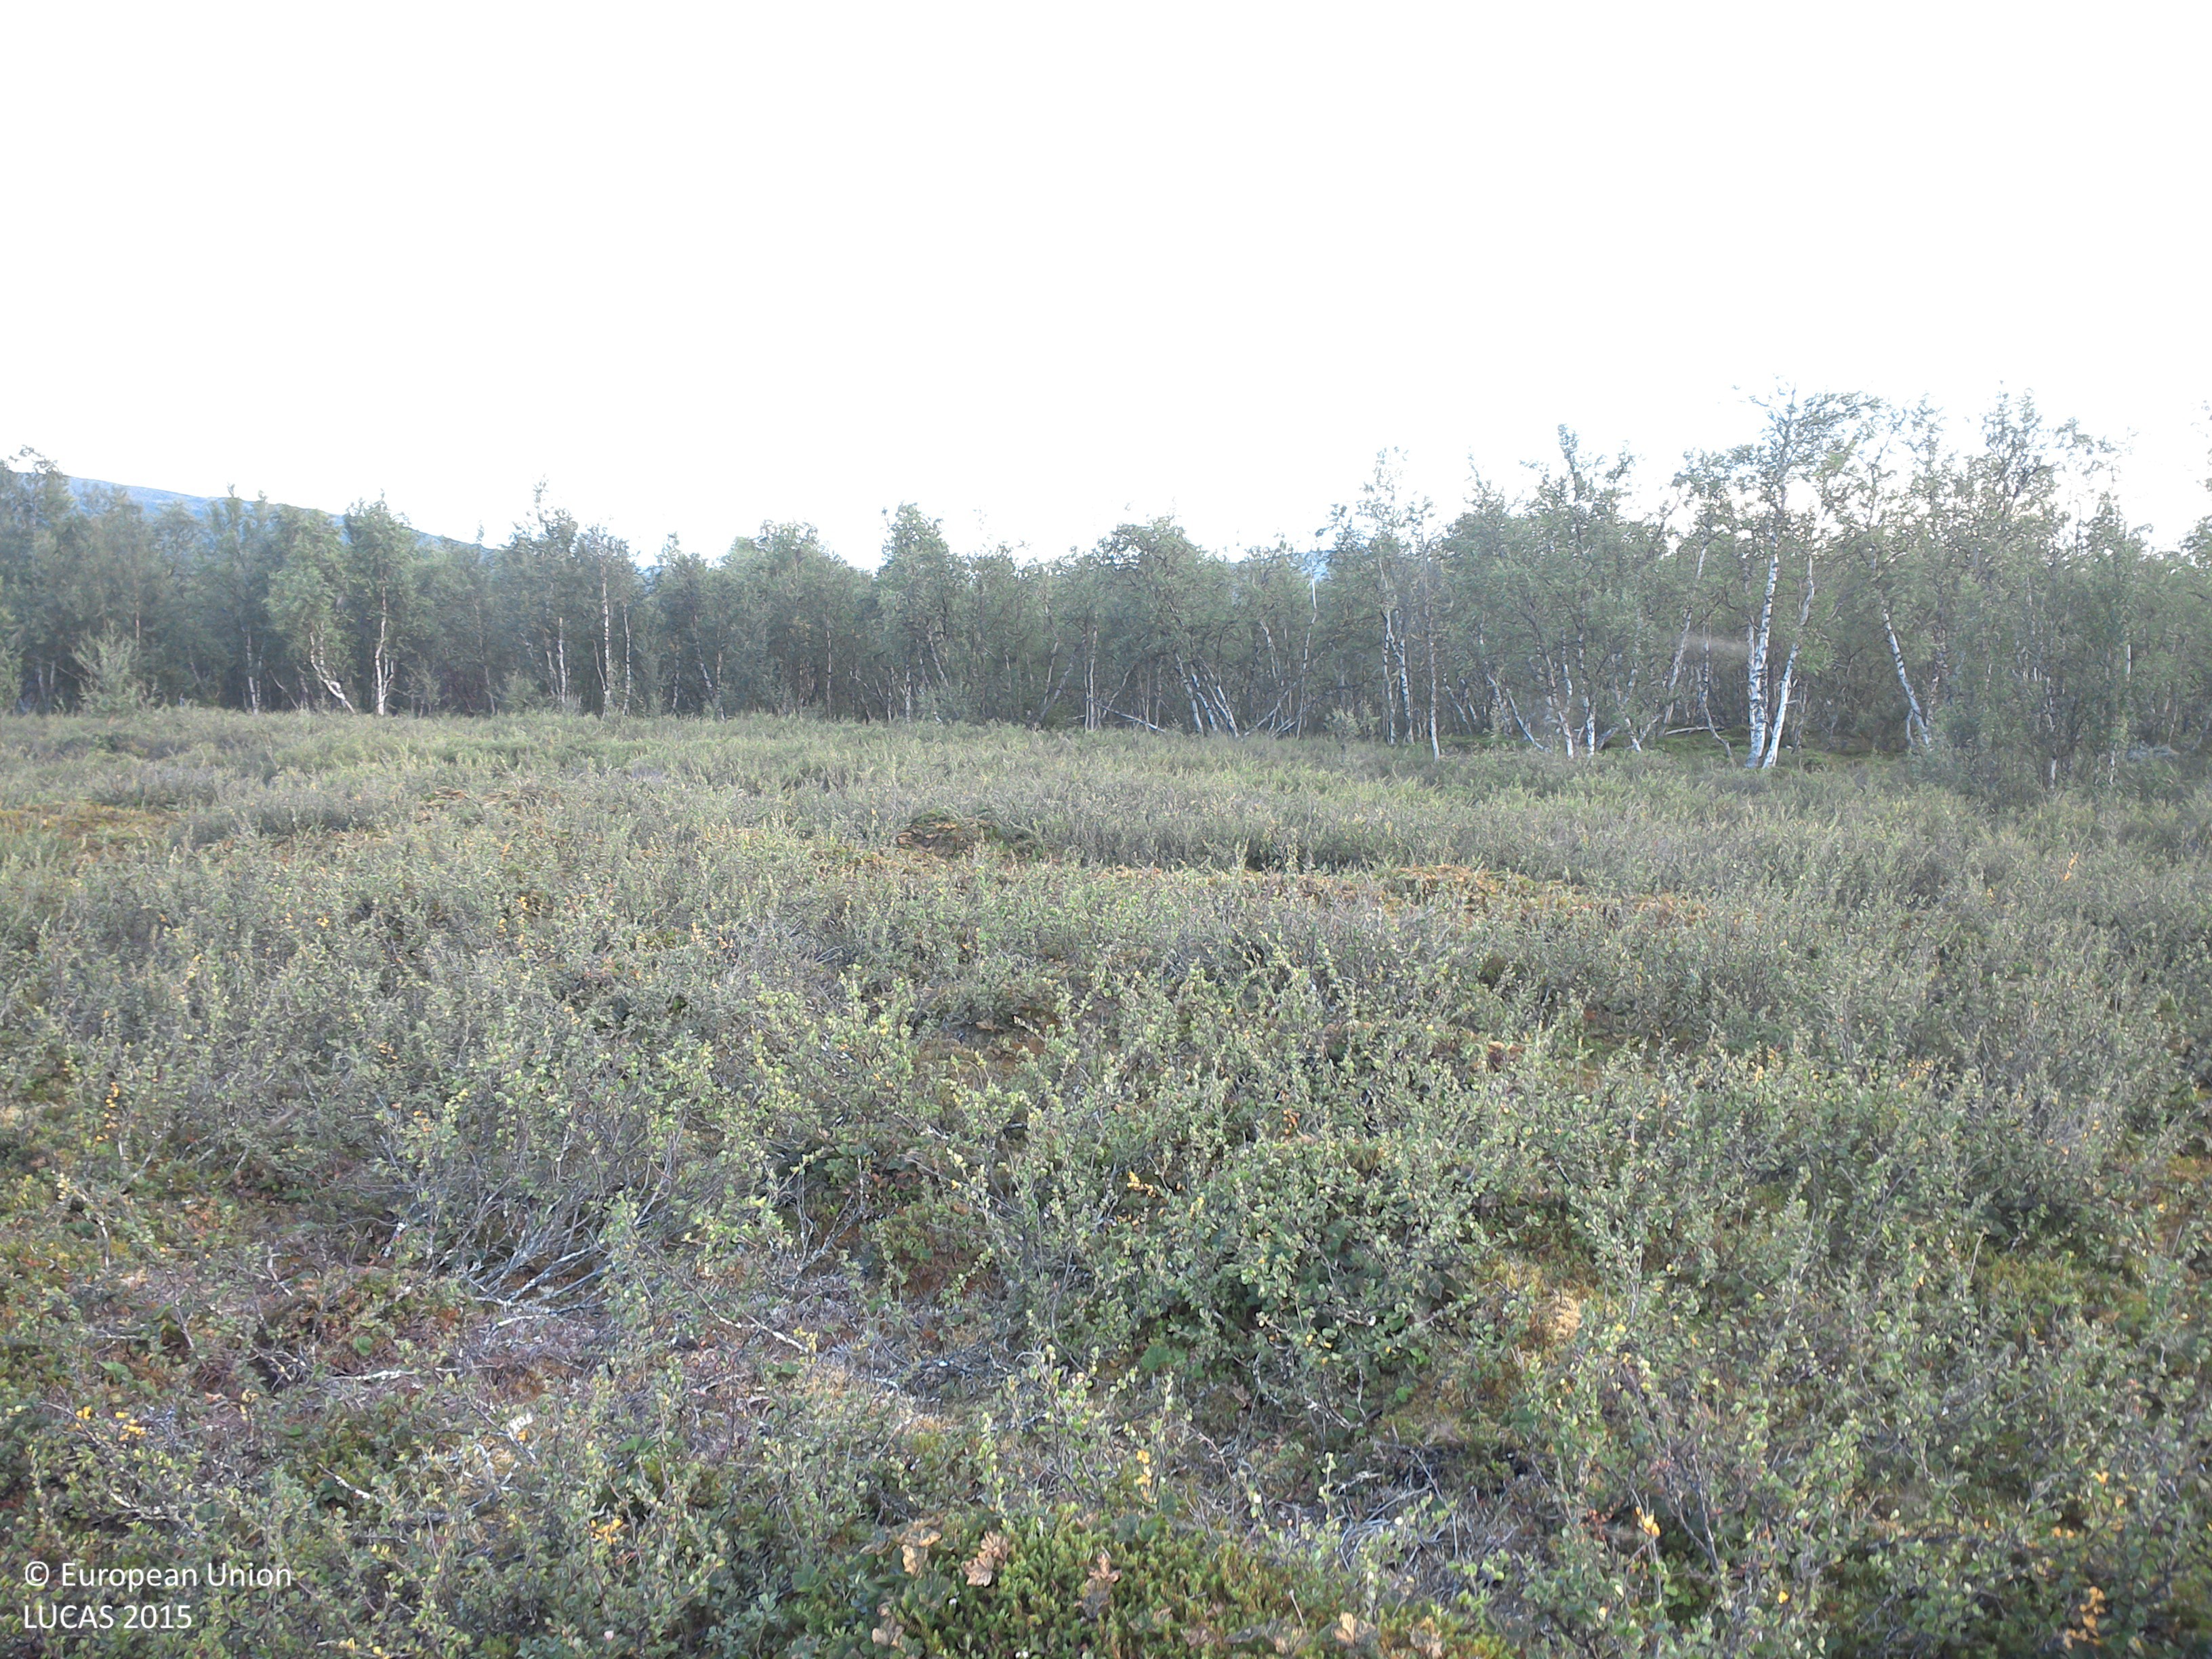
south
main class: Shrubland
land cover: Shrubland without tree cover
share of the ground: 25 - 50 %
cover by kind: shrubs 45 %, lichens and mosses 40 %, herbaceous plants 15 %
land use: Semi-natural and natural areas not in use
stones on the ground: < 10 %
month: August
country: SE
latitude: 67.8648
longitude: 19.2837
